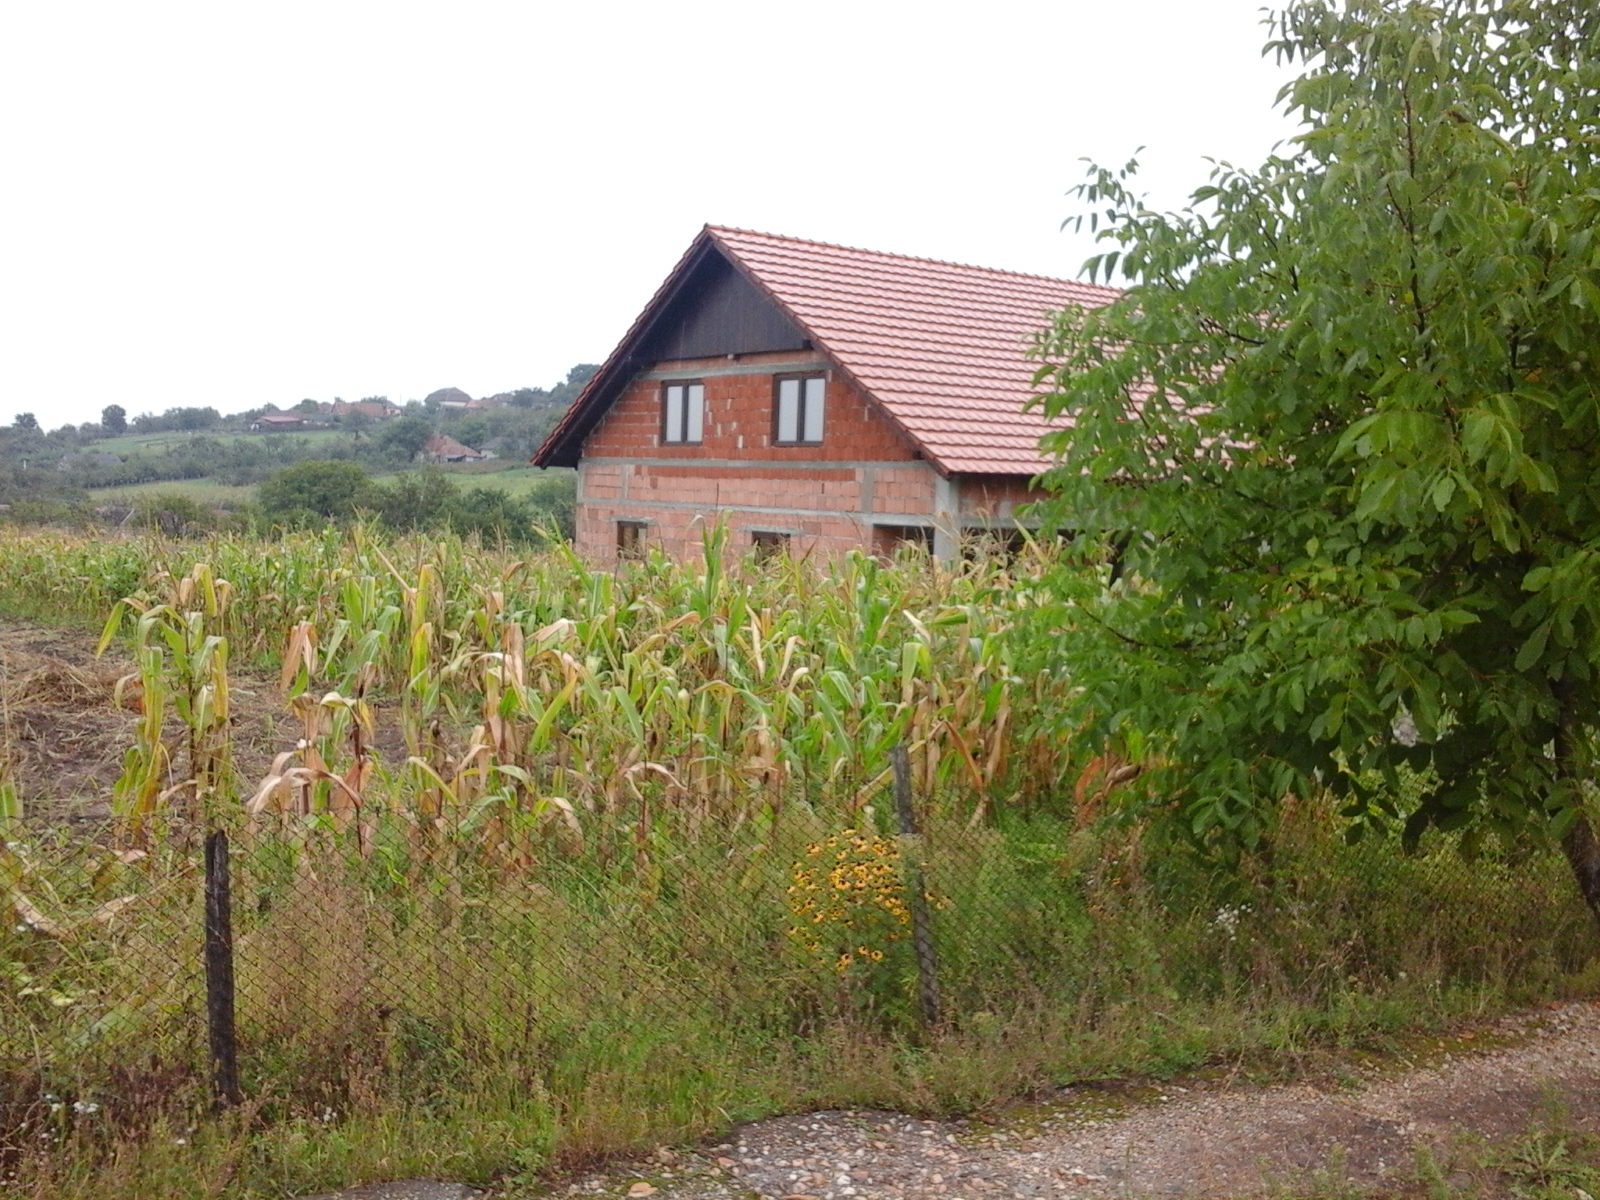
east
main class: Cropland
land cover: Maize
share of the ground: > 75 %
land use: Agriculture (excluding fallow land and kitchen gardens)
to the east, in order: Maize; Artificial constructions in urban areas; Arable land (only in case pi); Grassland without tree/shrub cover
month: September
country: RO
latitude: 47.2105
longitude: 22.5596
